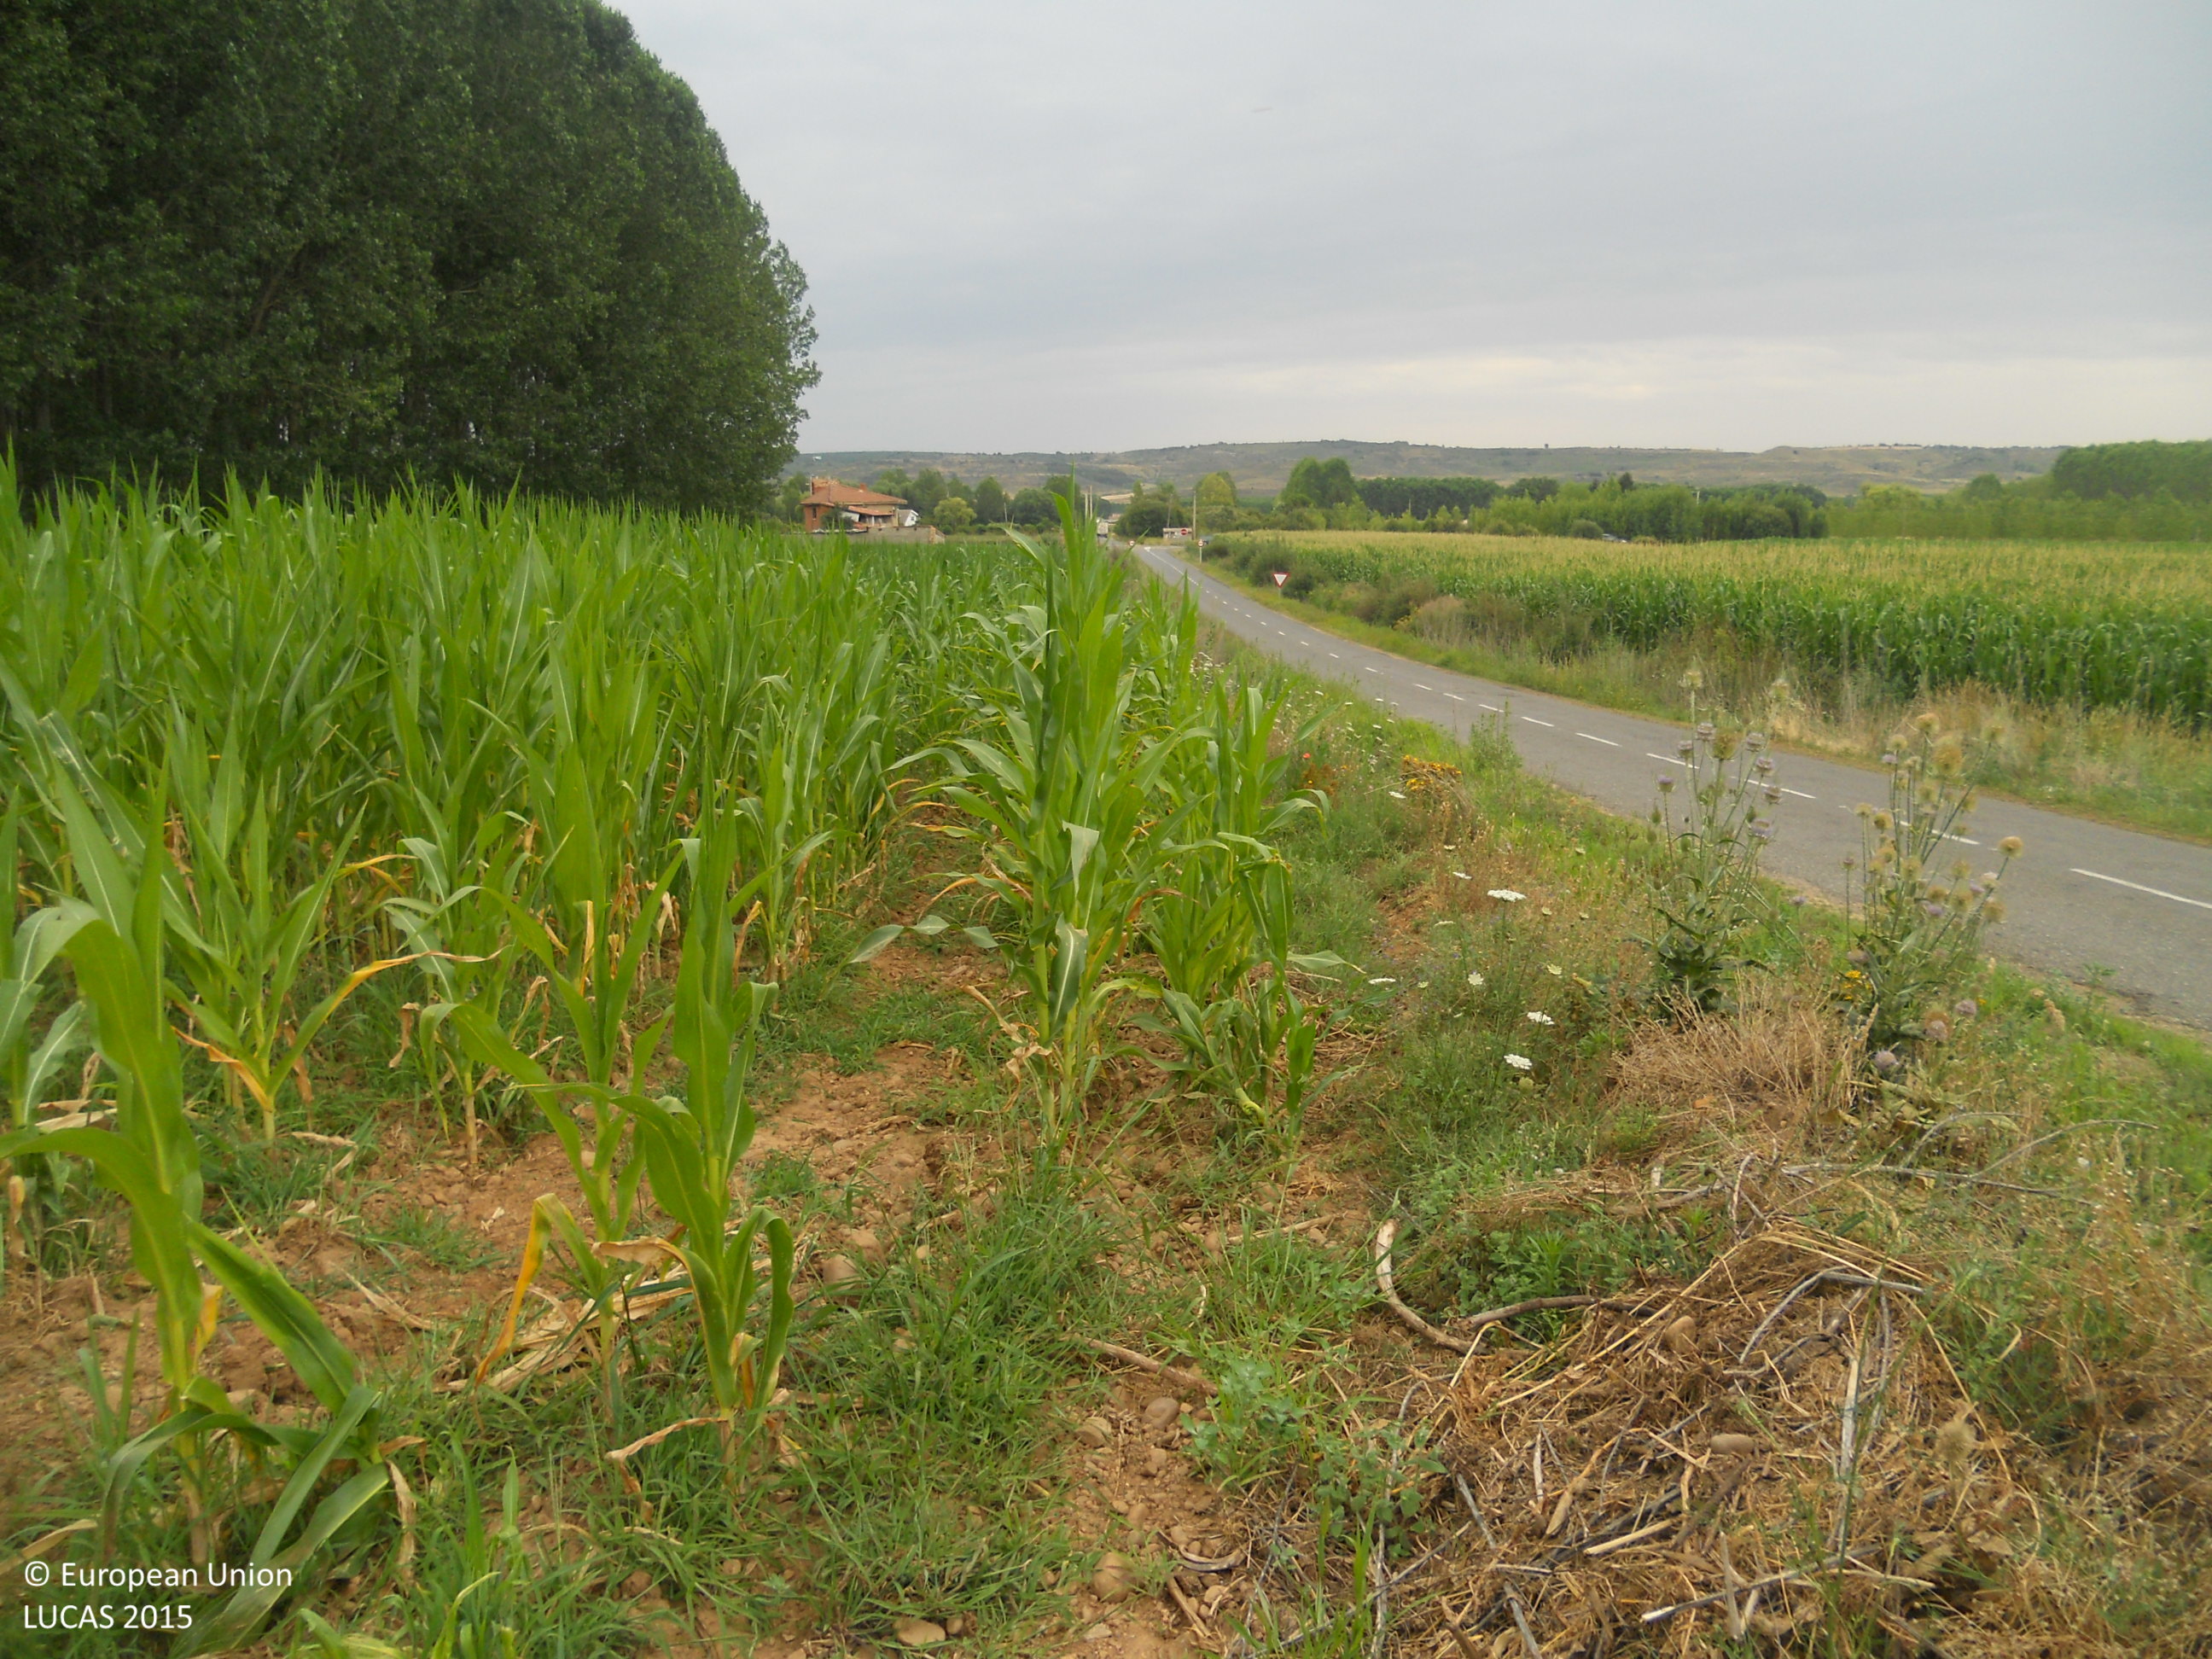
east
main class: Cropland
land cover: Maize
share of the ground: > 75 %
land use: Agriculture (excluding fallow land and kitchen gardens)
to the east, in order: Grass margins; Maize; Grass margins; Ditches and canals; Grass margins; Maize; Artificial constructions in urban areas; Grass margins; Tracks; Grass margins; Ditches and canals; Grass margins; Paved roads, cycling and walking lanes; Grassland without tree/shrub cover
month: July
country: ES
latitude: 42.6424
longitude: -5.4004
